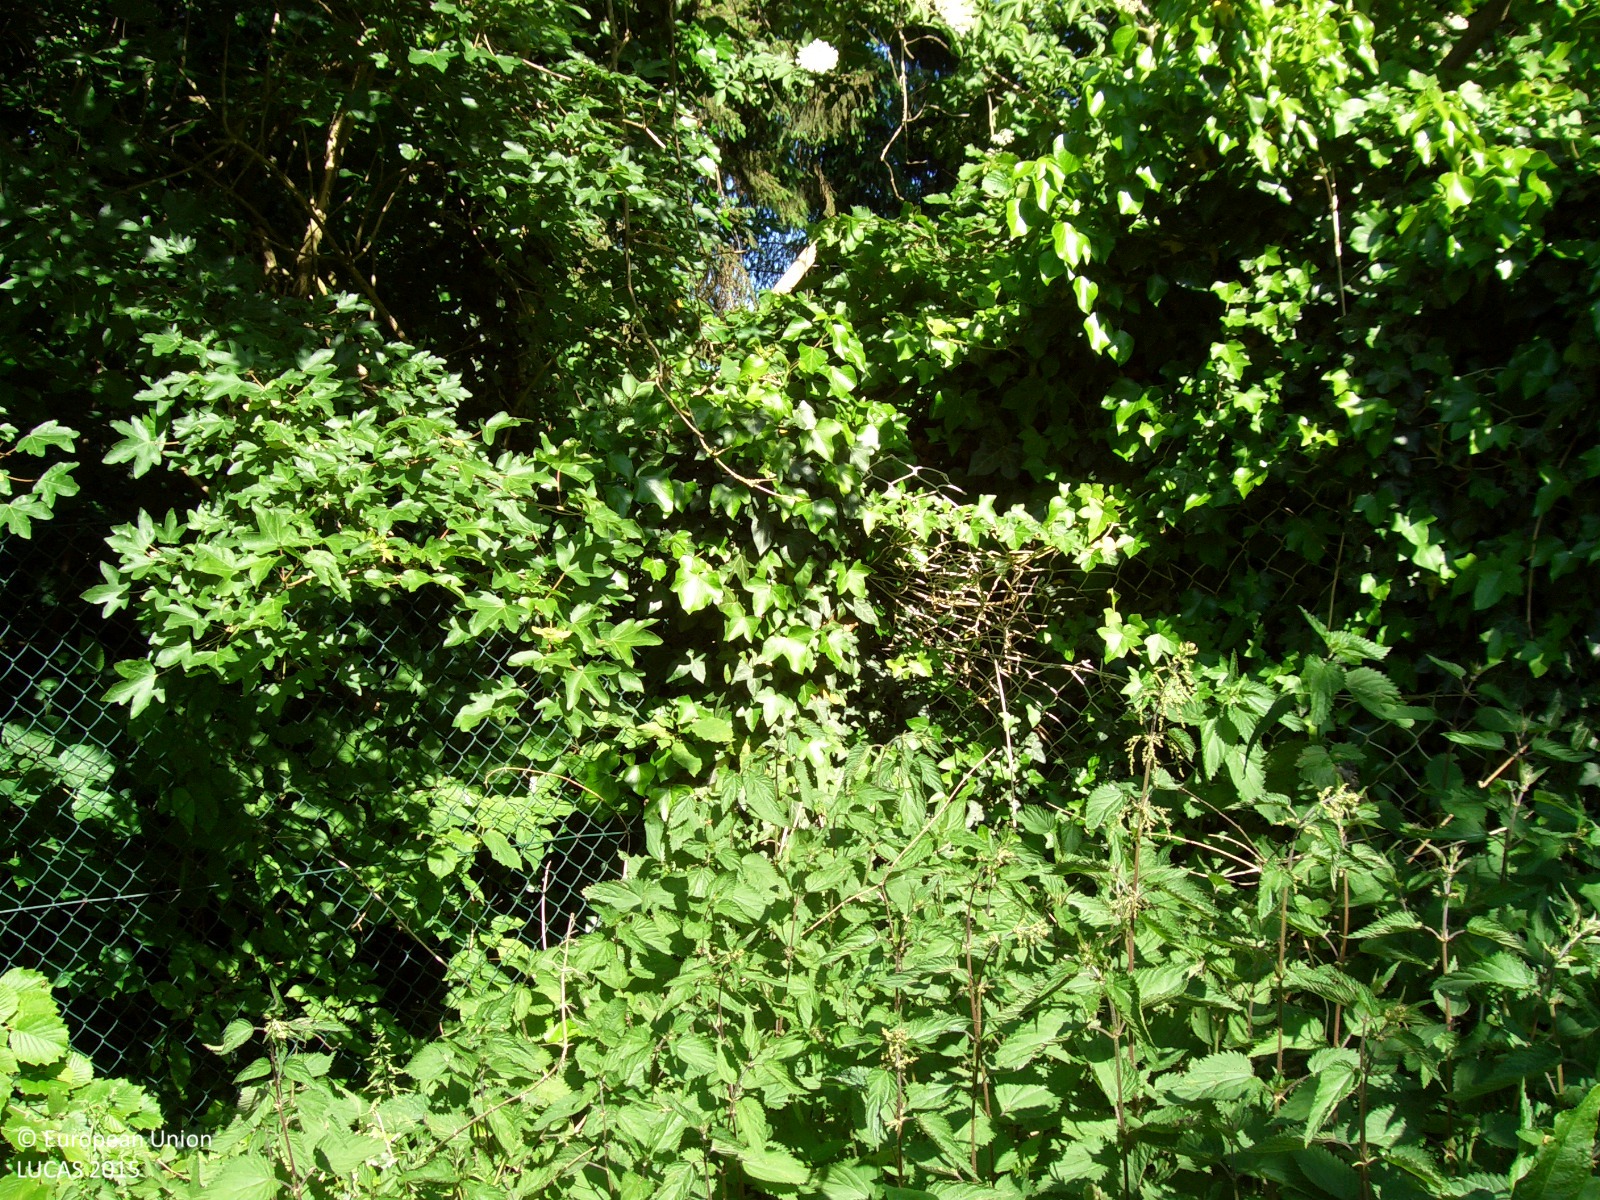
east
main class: Woodland
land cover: Other mixed woodland
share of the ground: > 75 %
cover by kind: broadleaved forest trees 50 %, coniferous forest trees 40 %, herbaceous plants 10 %
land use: Residential
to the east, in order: Other mixed woodland; Artificial constructions in urban areas
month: June
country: DE
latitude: 50.8242
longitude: 6.2373
